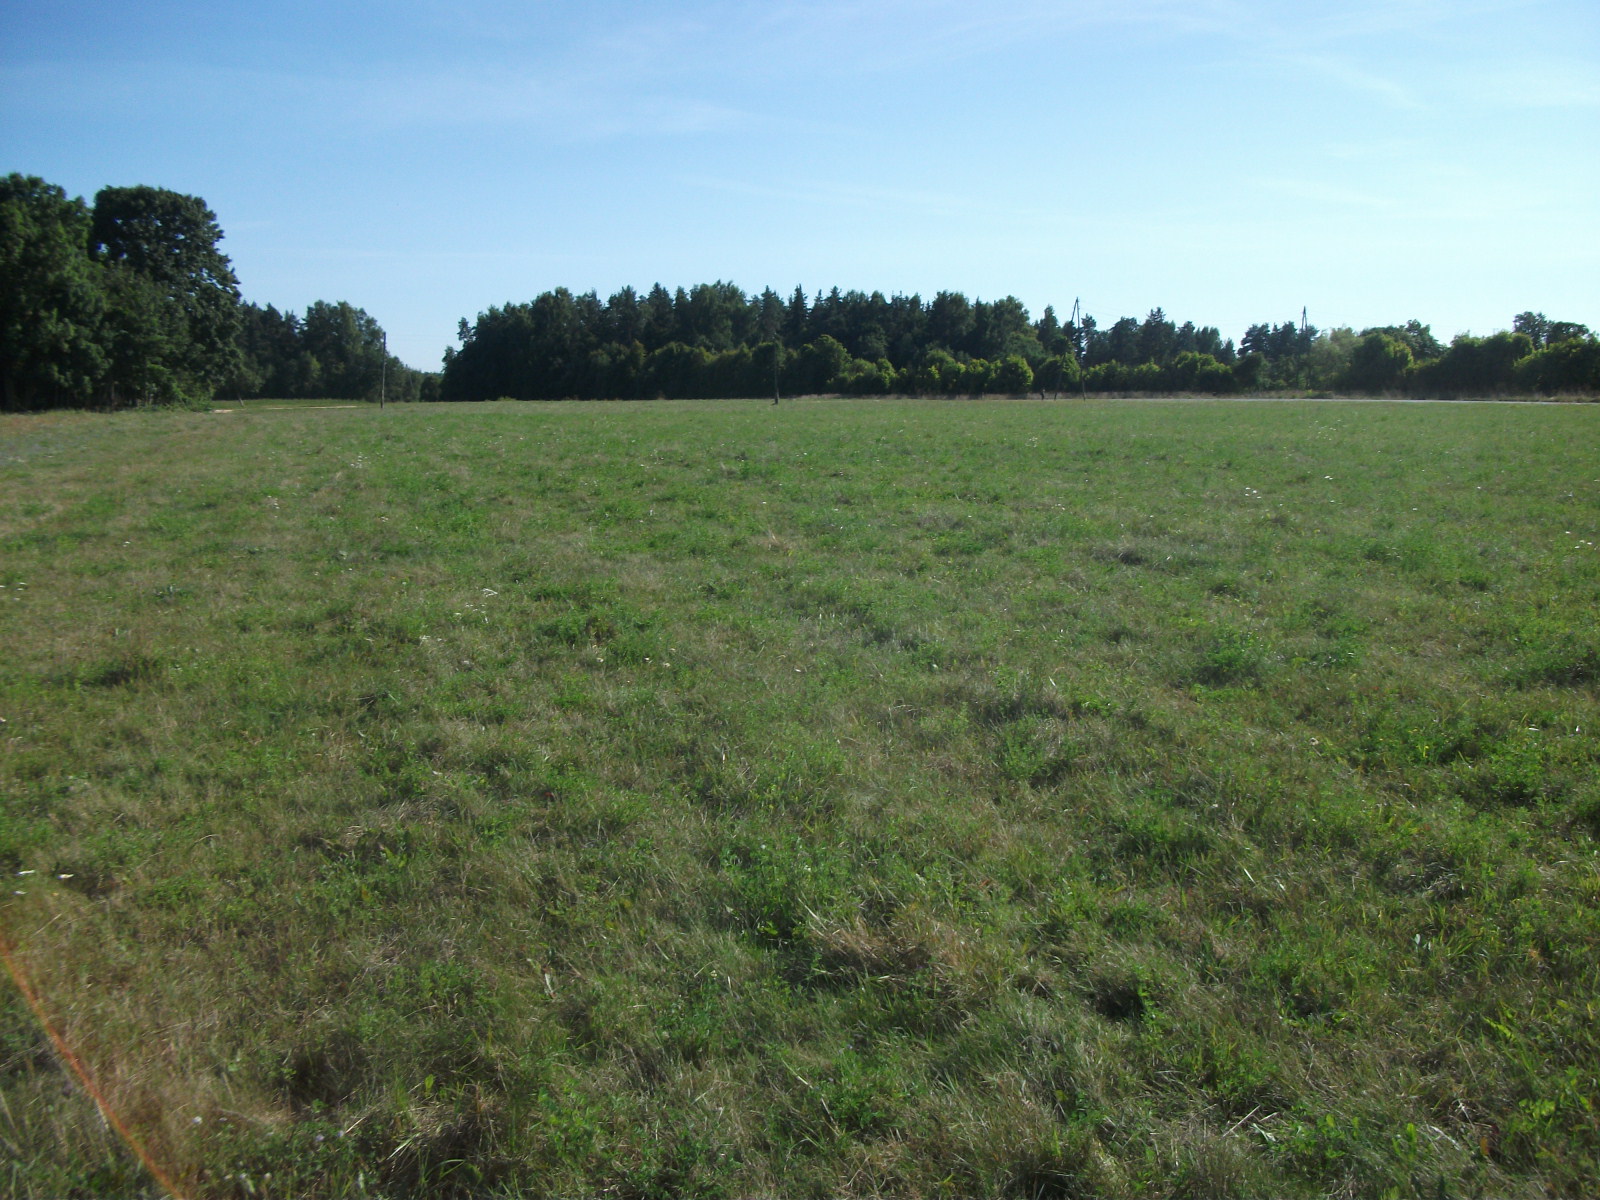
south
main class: Grassland
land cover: Grassland without tree/shrub cover
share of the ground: > 75 %
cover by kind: herbaceous plants 100 %
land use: Agriculture (excluding fallow land and kitchen gardens)
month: August
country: LV
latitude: 56.3077
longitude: 26.1902
